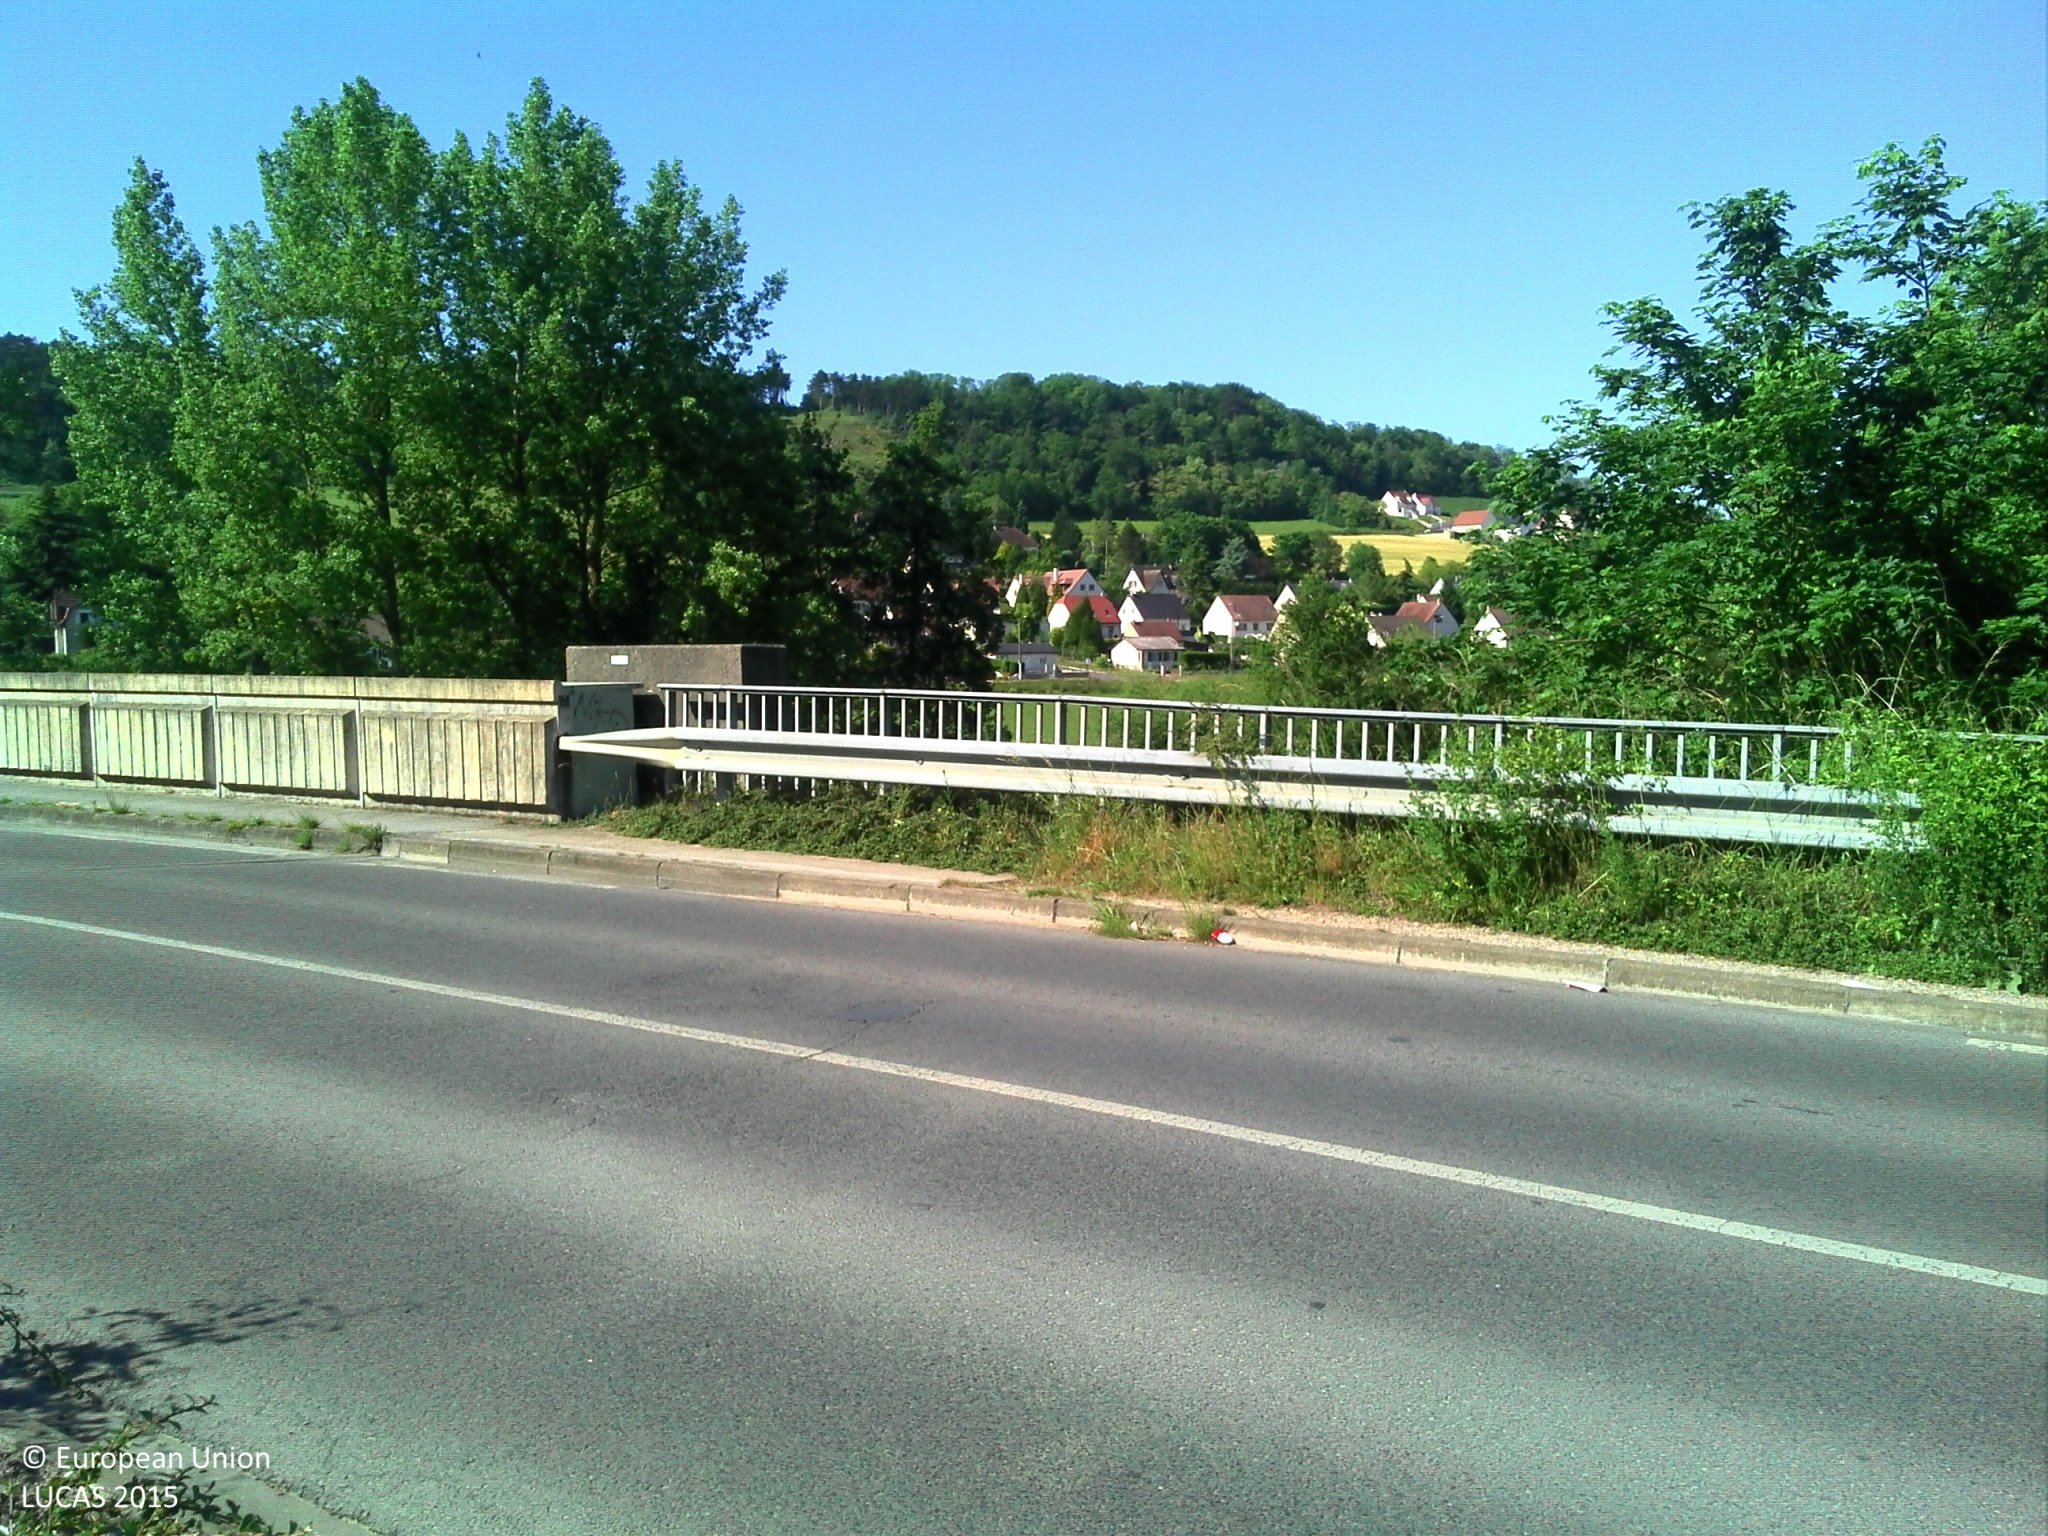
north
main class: Grassland
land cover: Spontaneously vegetated surfaces
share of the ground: > 75 %
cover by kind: herbaceous plants 95 %, shrubs 5 %
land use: Semi-natural and natural areas not in use
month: June
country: FR
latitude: 49.3922
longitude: 3.3099
